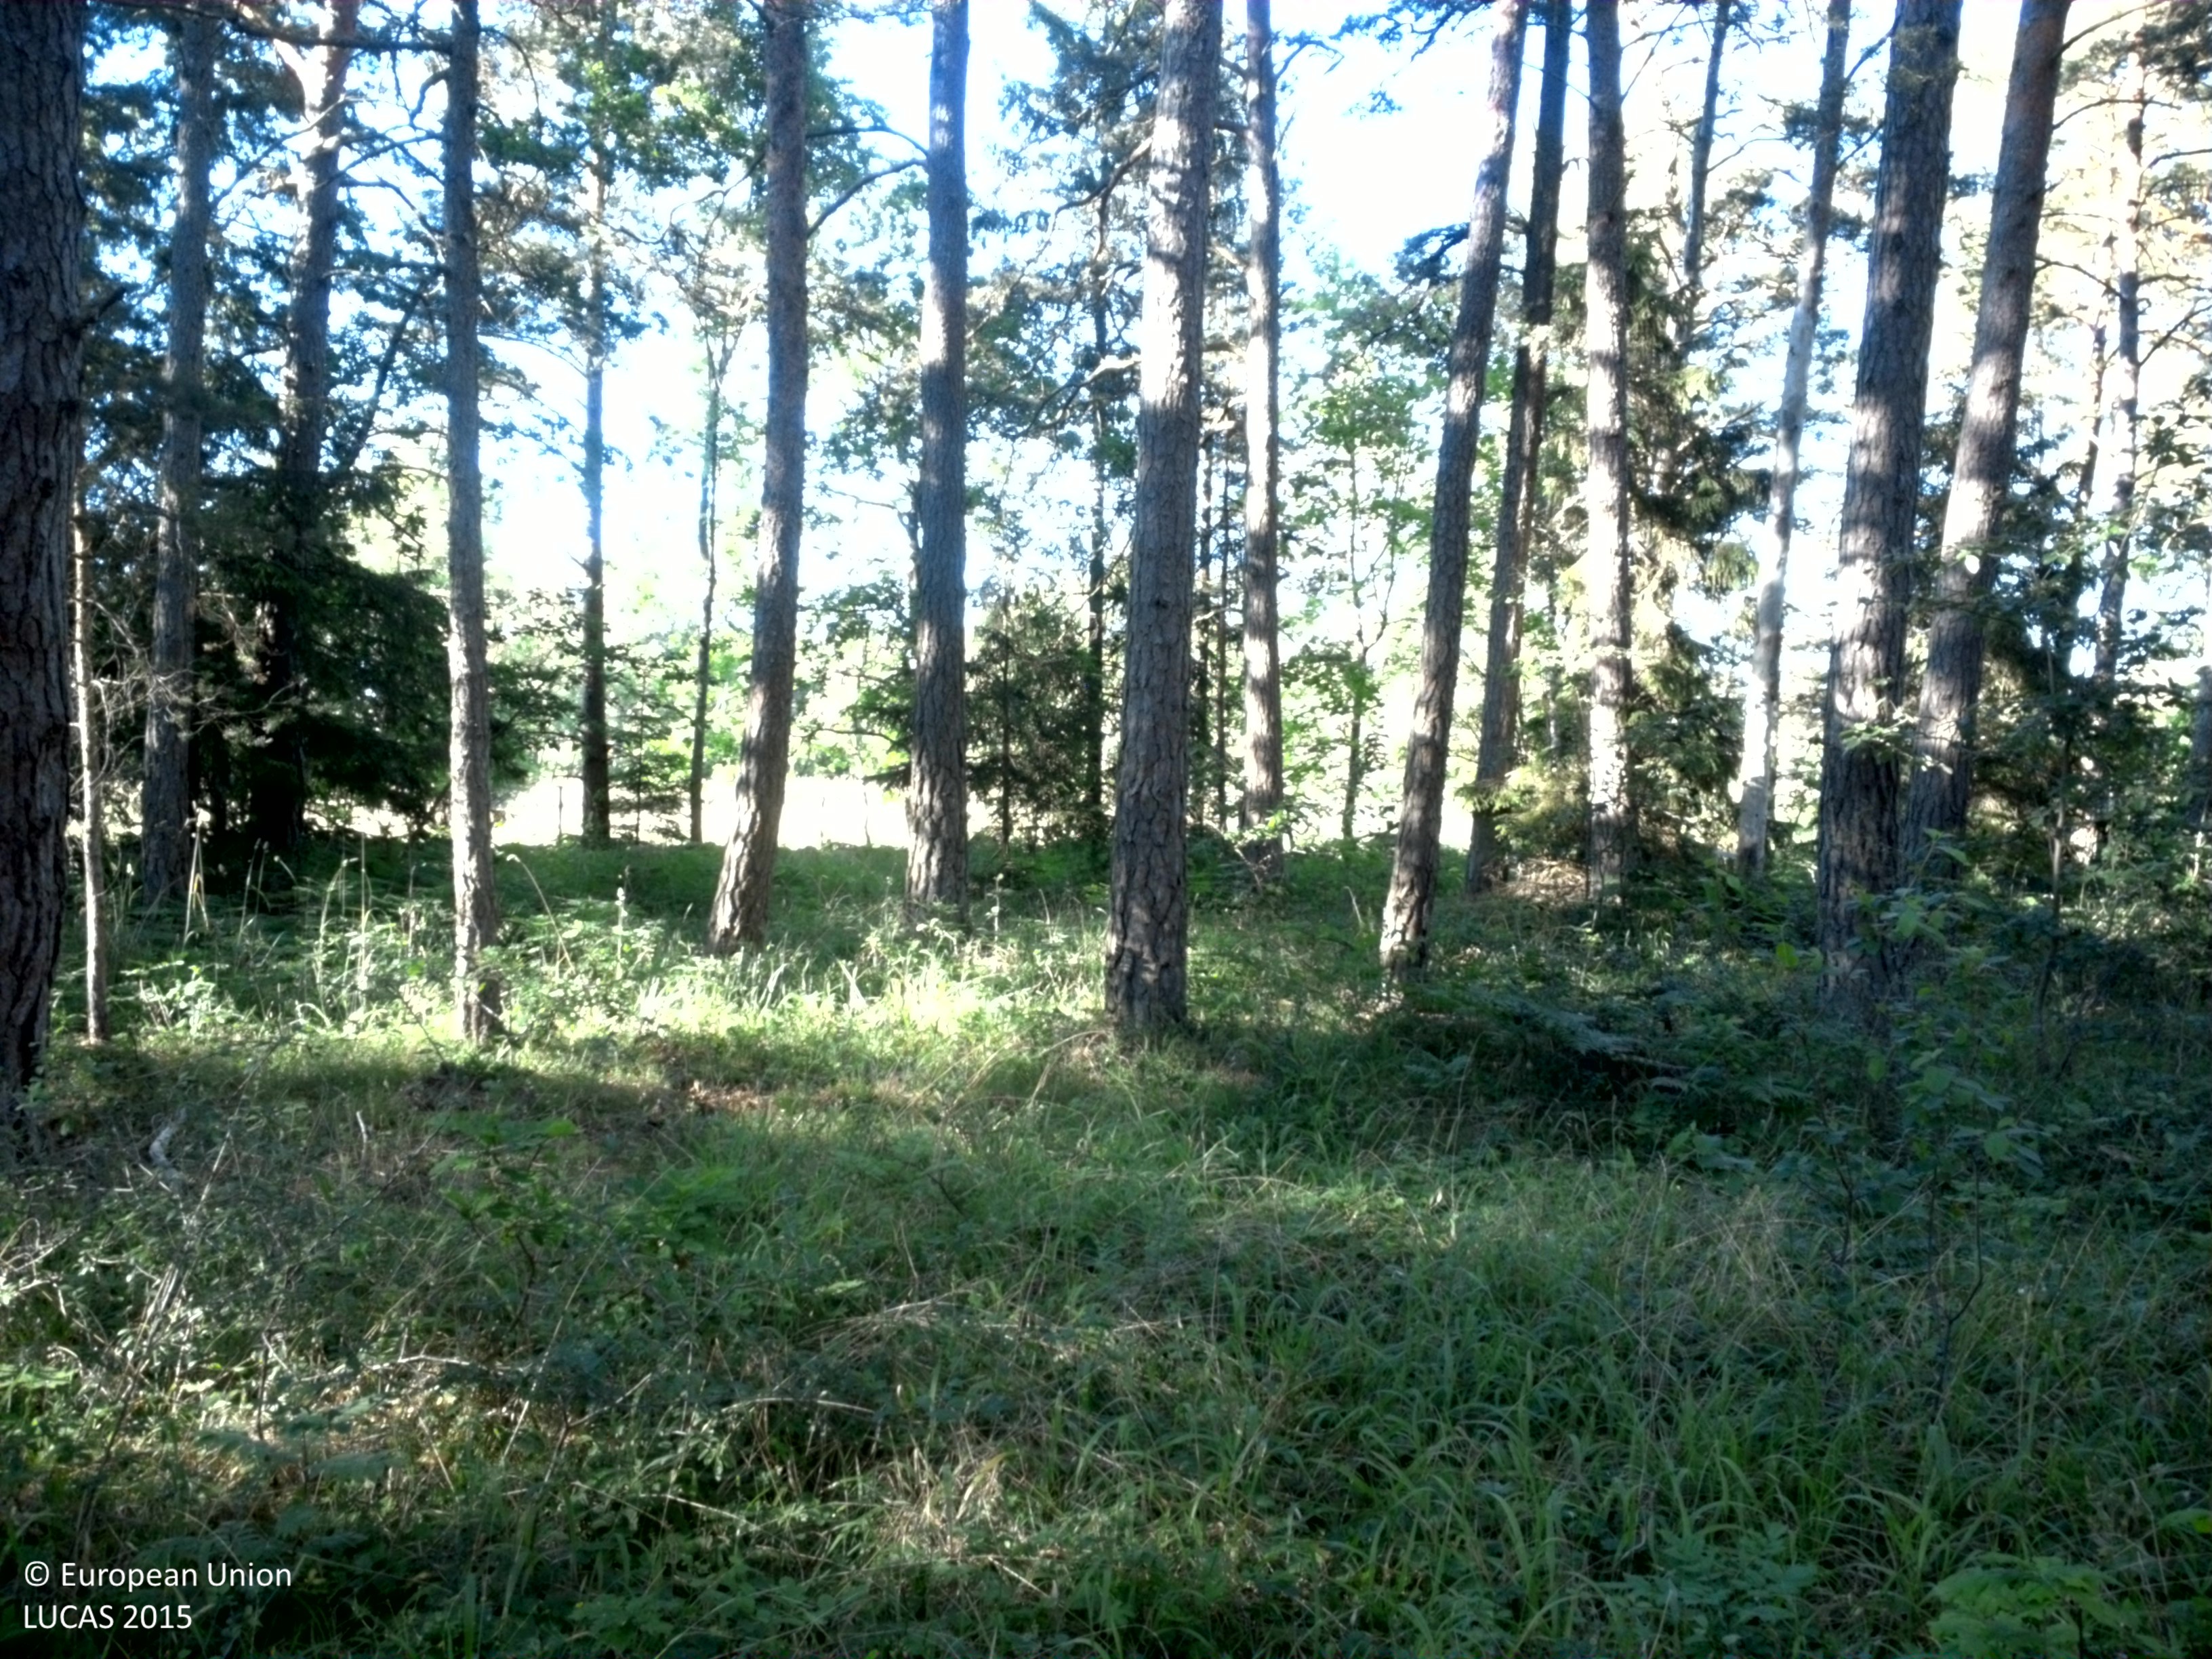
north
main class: Woodland
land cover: Pine dominated coniferous woodland
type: hemiboreal forest and nemoral coniferous forest and mixed broadleaved-coniferous forest
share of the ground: > 75 %
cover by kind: coniferous forest trees 80 %, herbaceous plants 15 %, broadleaved forest trees 5 %
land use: Forestry
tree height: > 5 m
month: July
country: SE
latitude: 57.8006
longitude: 18.5723
